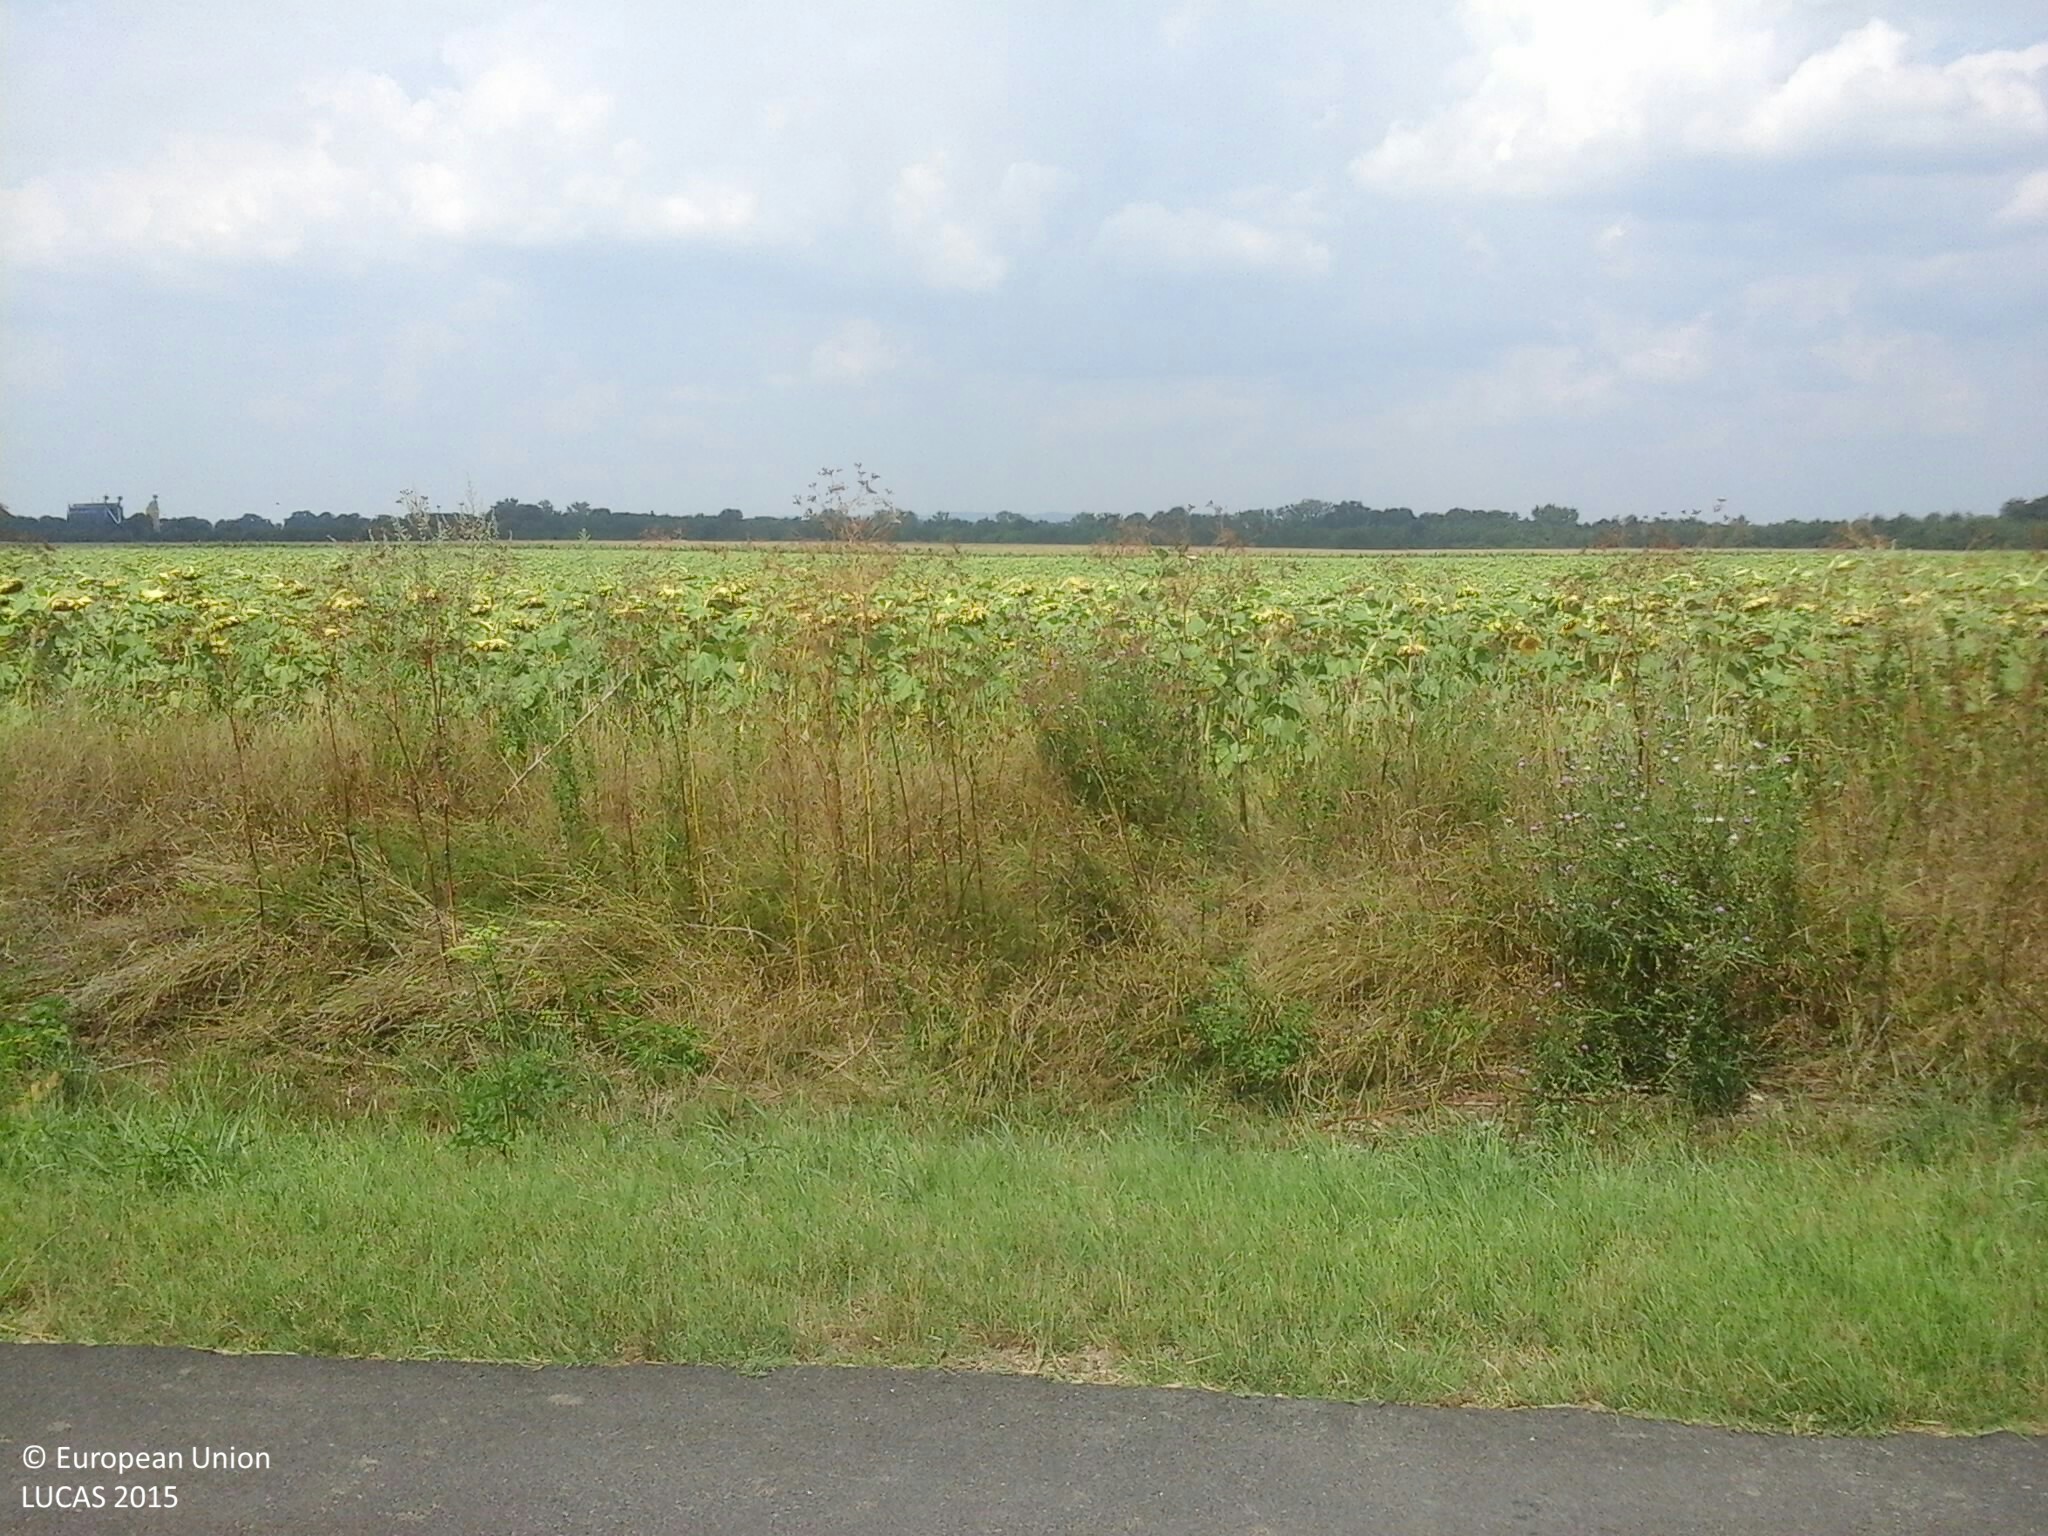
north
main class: Cropland
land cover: Maize
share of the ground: > 75 %
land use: Agriculture (excluding fallow land and kitchen gardens)
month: August
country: HU
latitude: 45.9675
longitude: 18.1493
